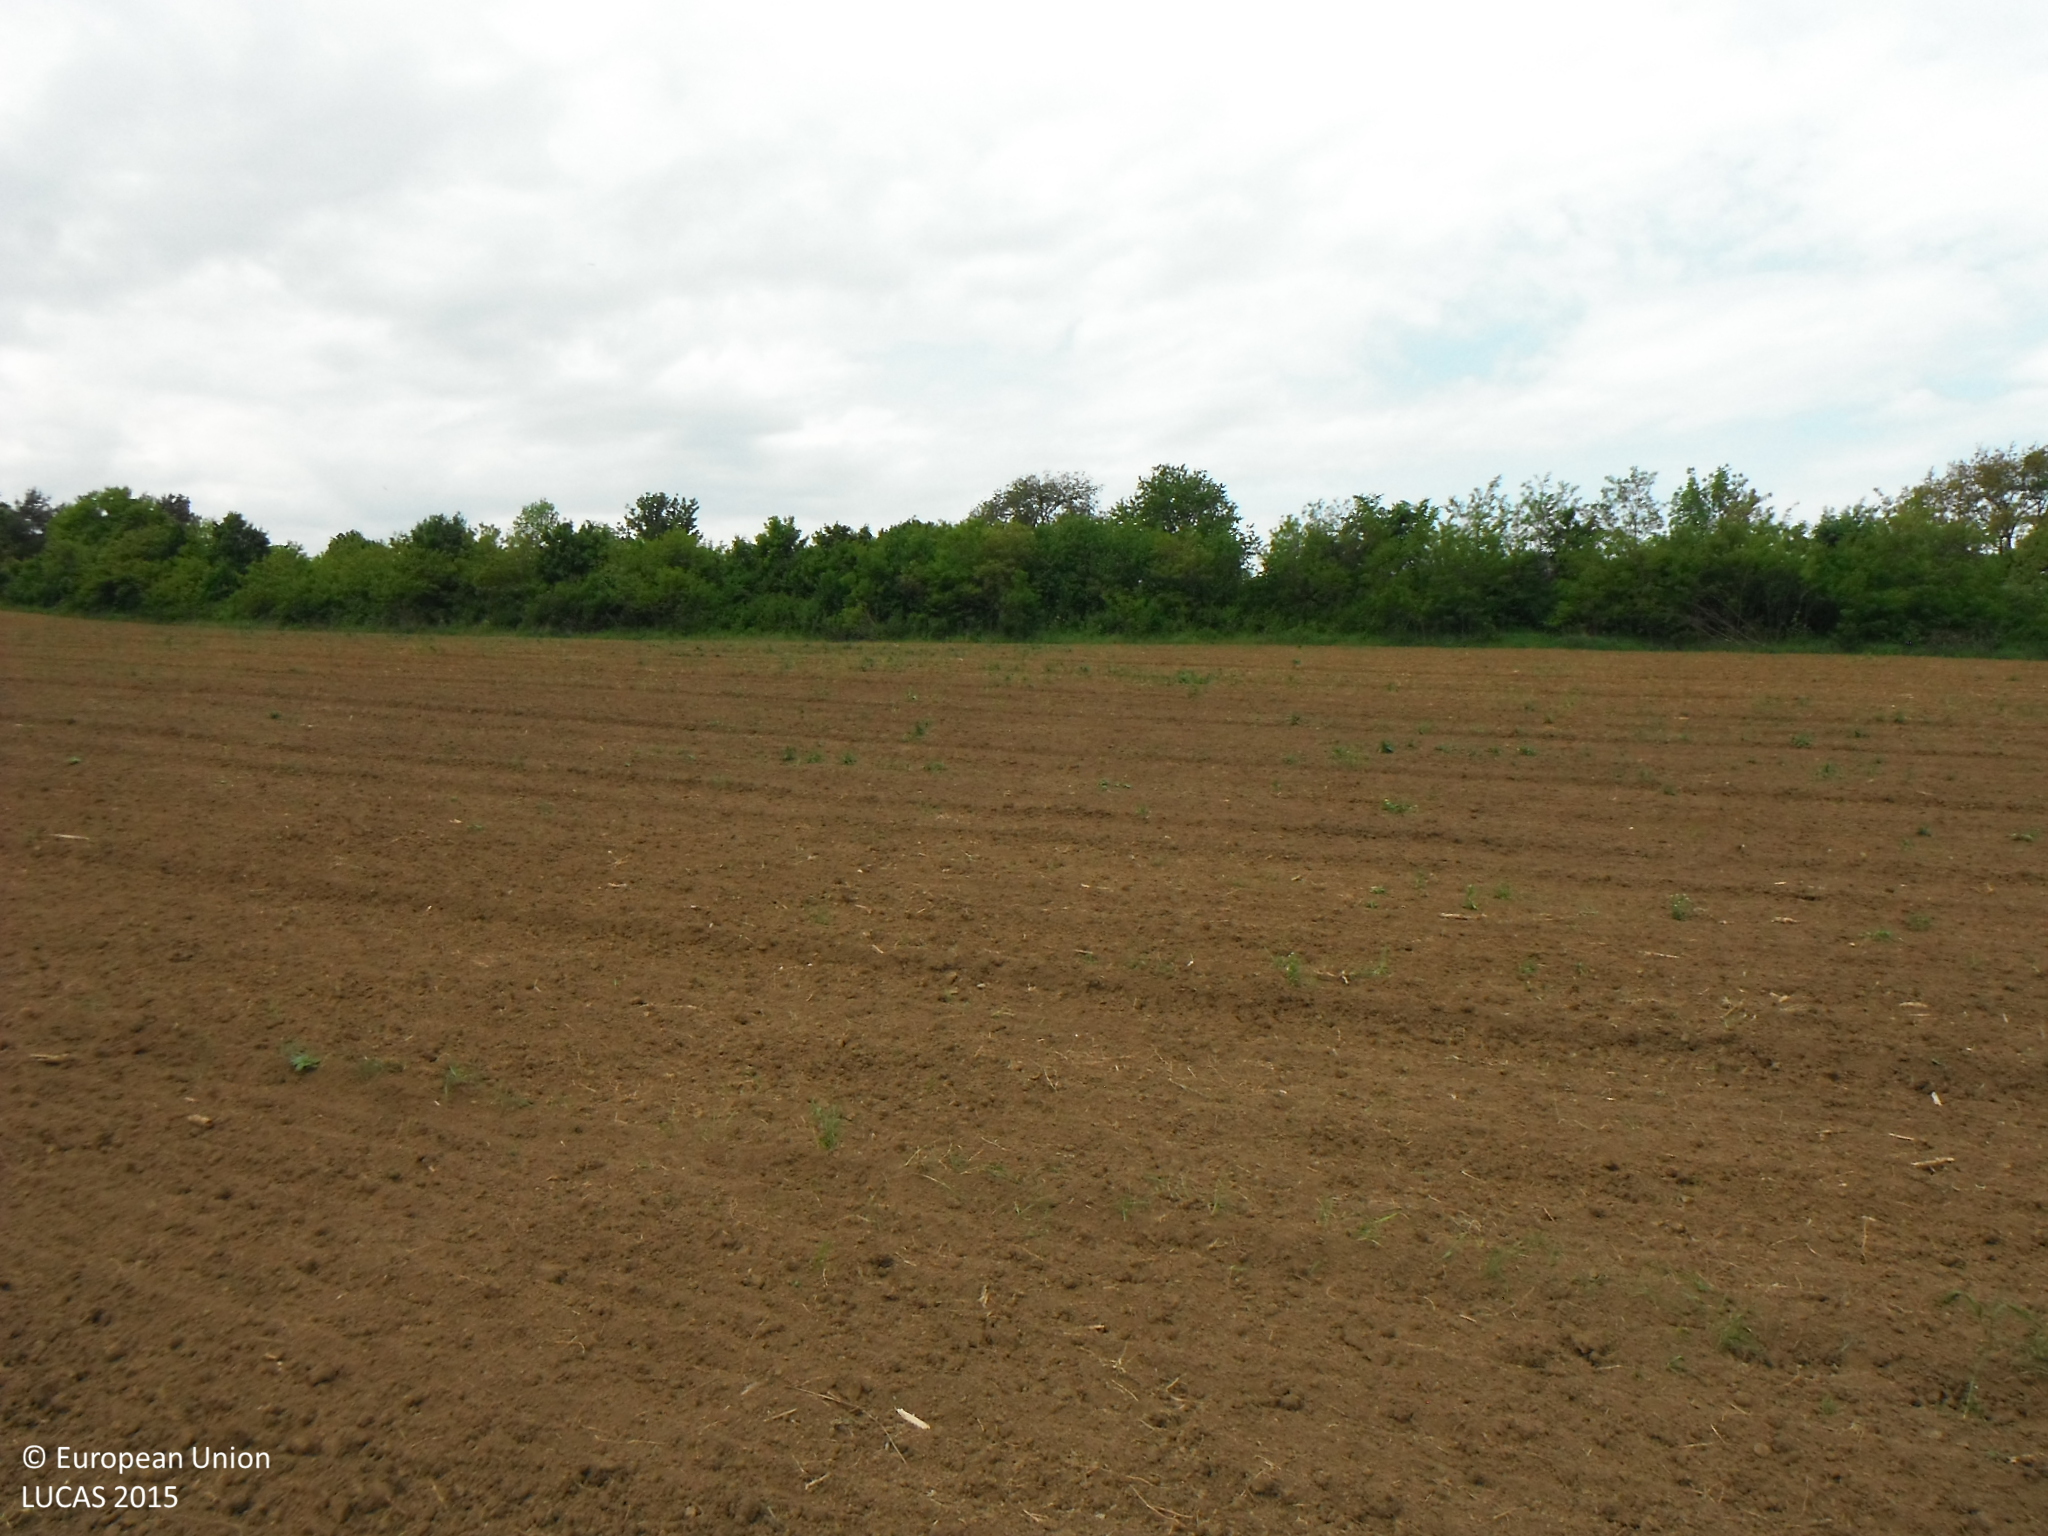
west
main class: Cropland
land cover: Other cereals
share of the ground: < 10 %
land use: Agriculture (excluding fallow land and kitchen gardens)
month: May
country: SK
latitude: 49.0579
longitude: 21.1145
